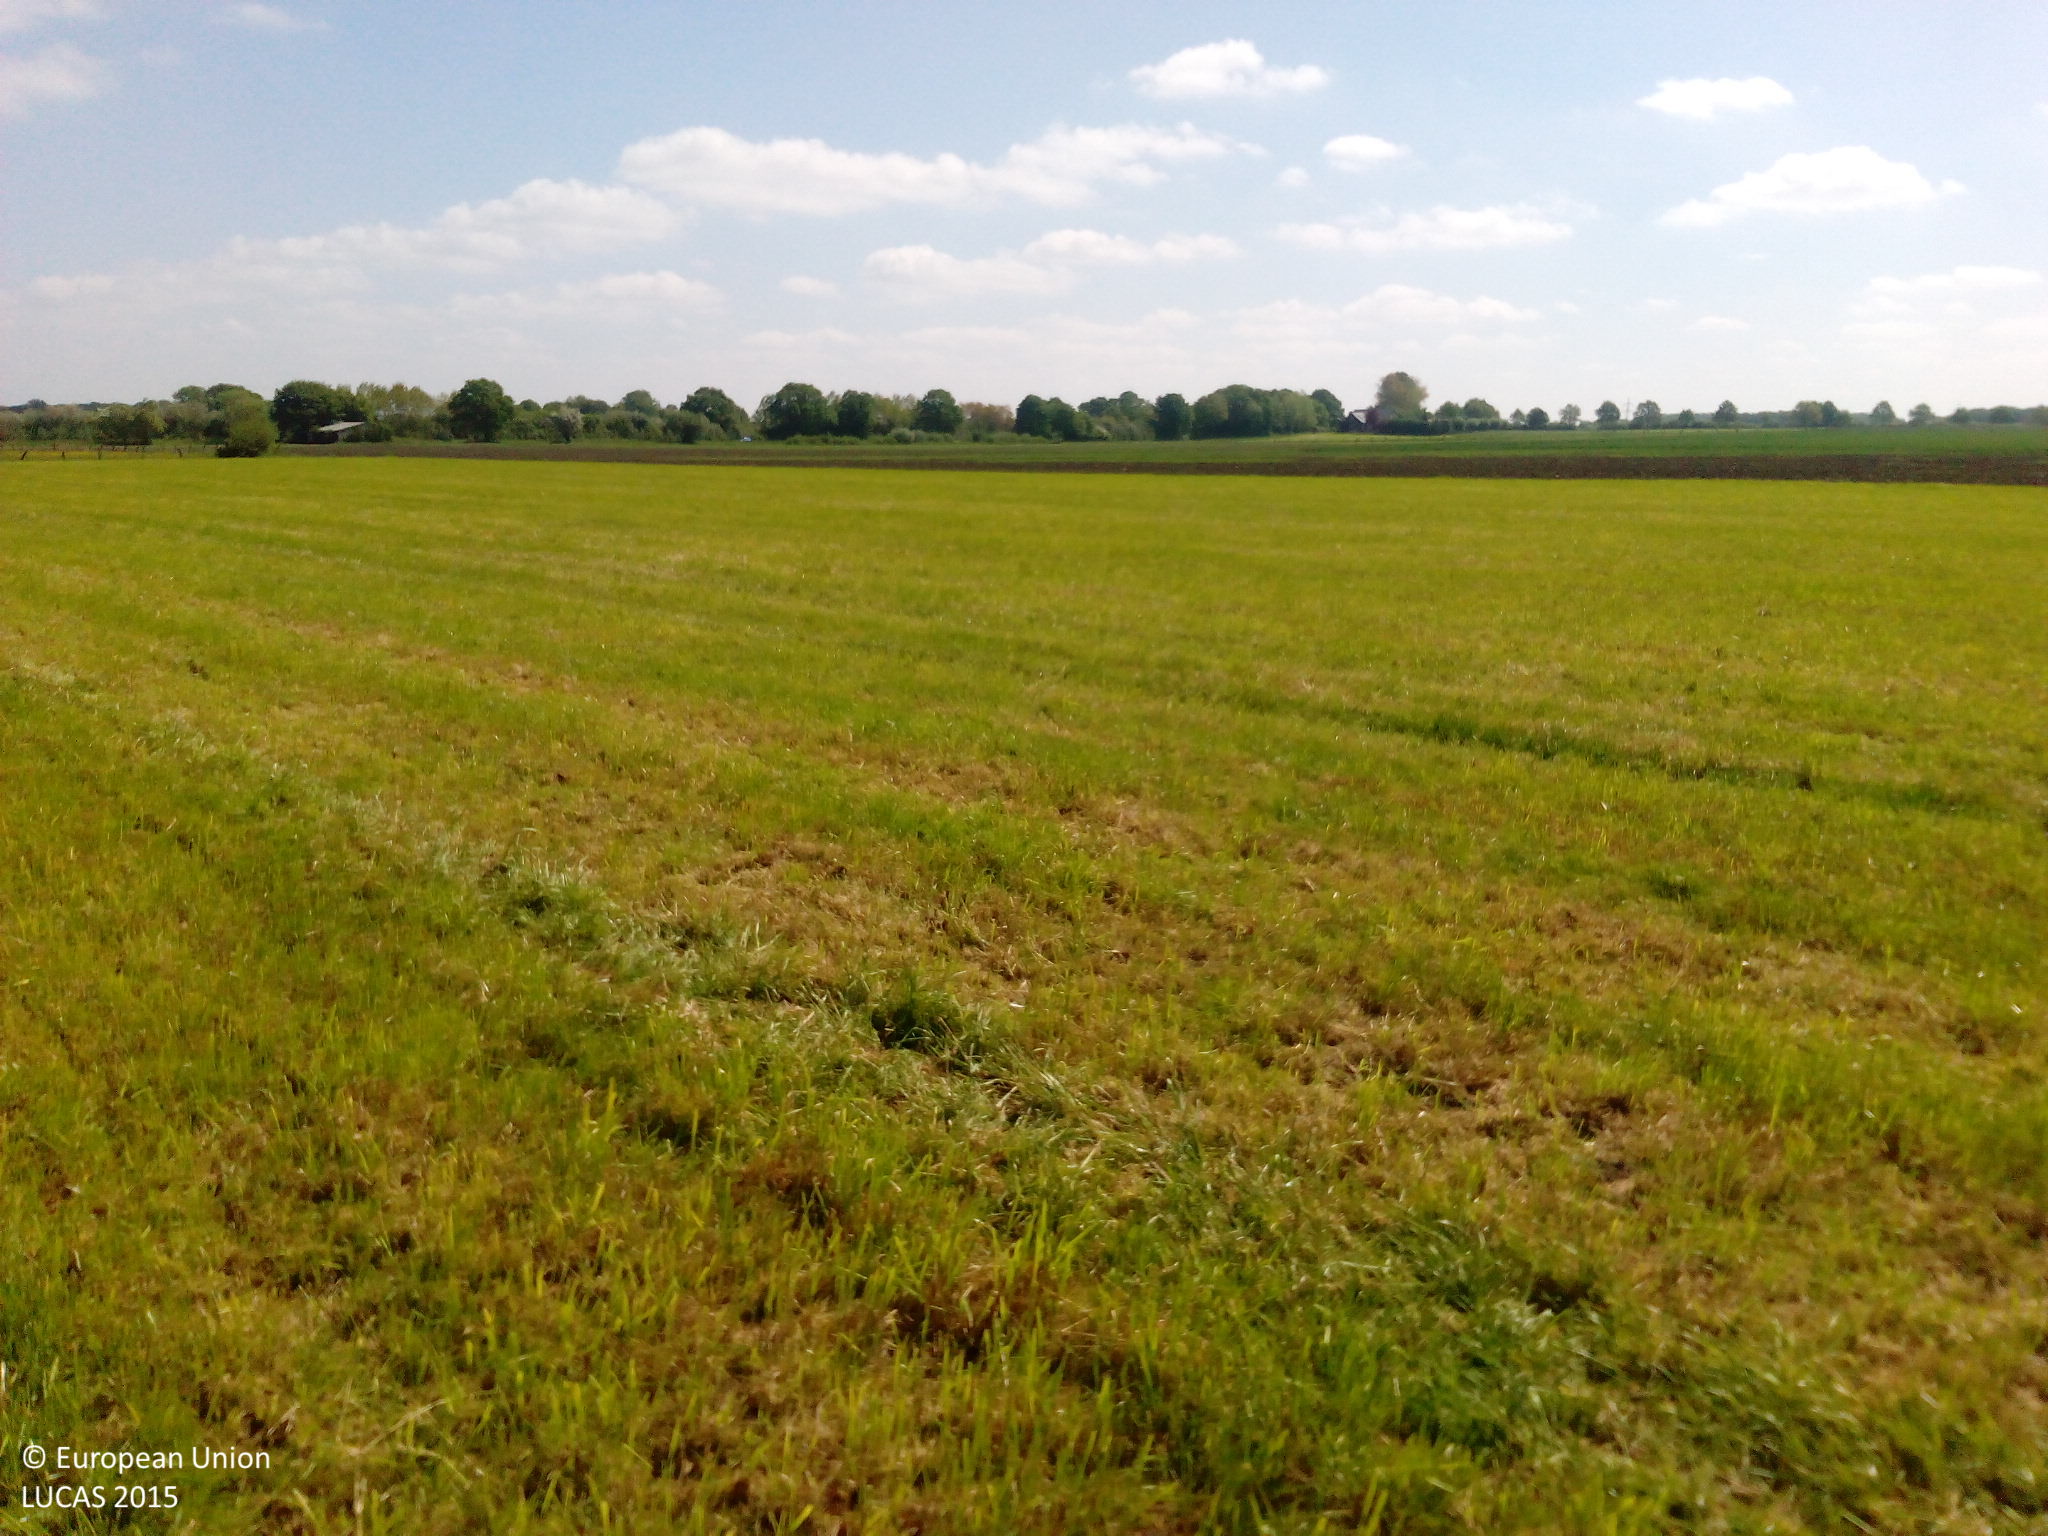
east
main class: Grassland
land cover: Grassland without tree/shrub cover
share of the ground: > 75 %
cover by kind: herbaceous plants 100 %
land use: Agriculture (excluding fallow land and kitchen gardens)
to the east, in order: Grassland without tree/shrub cover; Fences; Grassland without tree/shrub cover; Maize
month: May
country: DE
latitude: 51.9108
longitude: 7.9798
